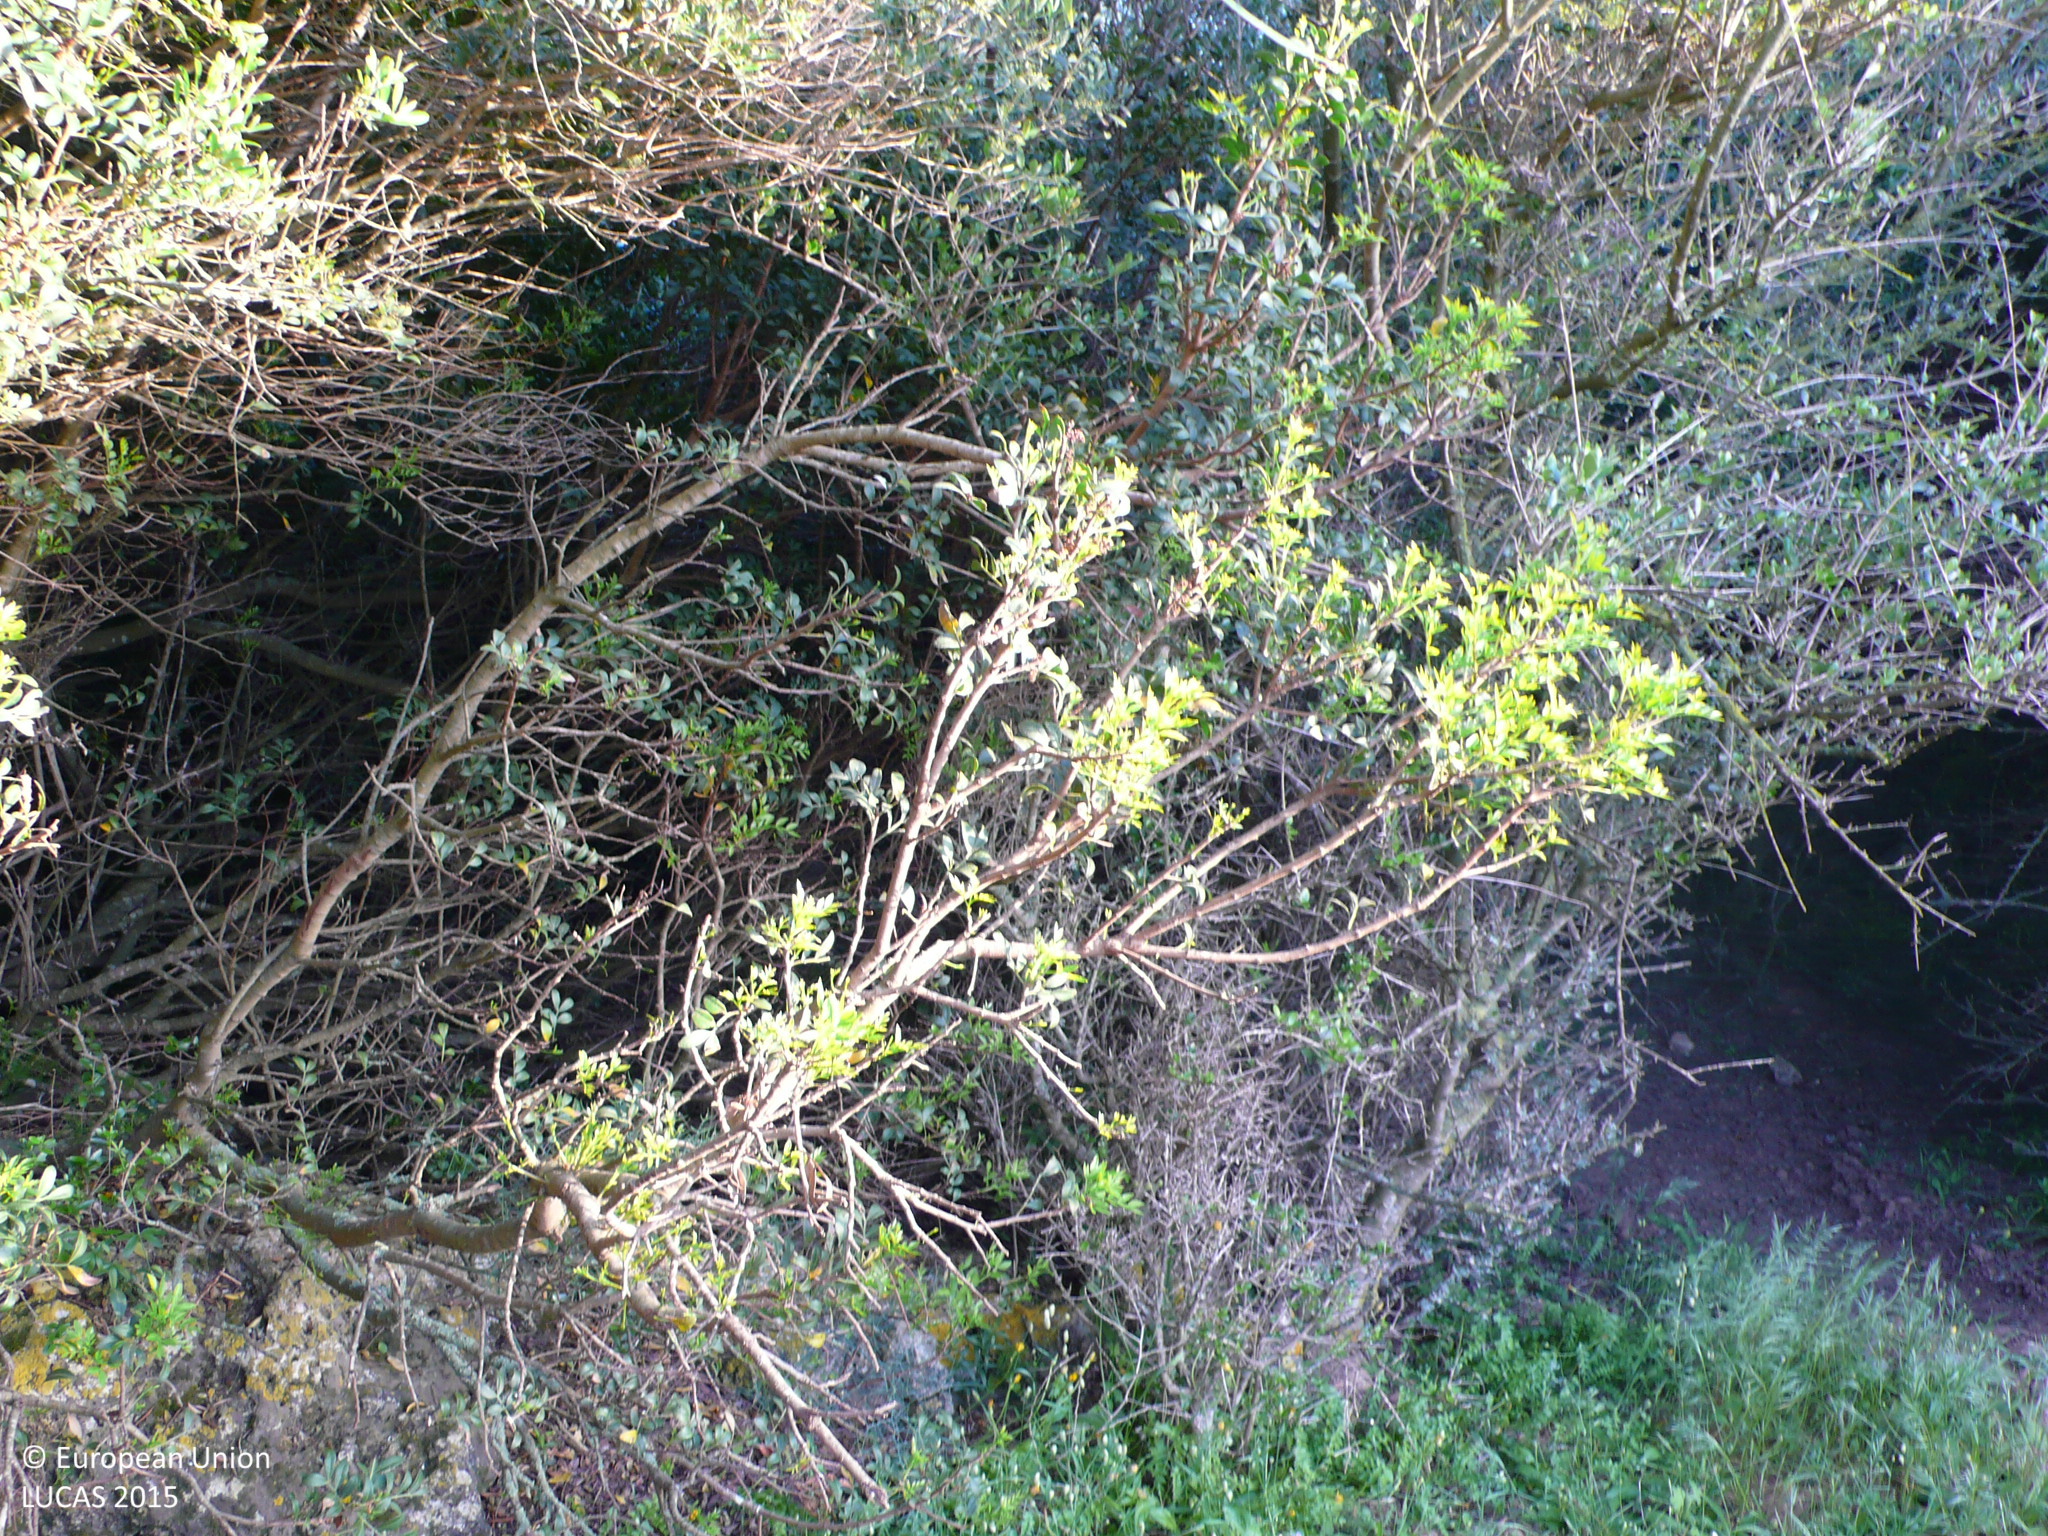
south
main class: Woodland
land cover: Broadleaved woodland
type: broadleaved evergreen forest
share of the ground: 50 - 75 %
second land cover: Grassland without tree/shrub cover
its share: > 75 %
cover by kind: broadleaved forest trees 60 %, shrubs 20 %, herbaceous plants 20 %
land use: Forestry
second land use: Agriculture (excluding fallow land and kitchen gardens)
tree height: > 5 m
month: May
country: ES
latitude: 39.9135
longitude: 4.1885
